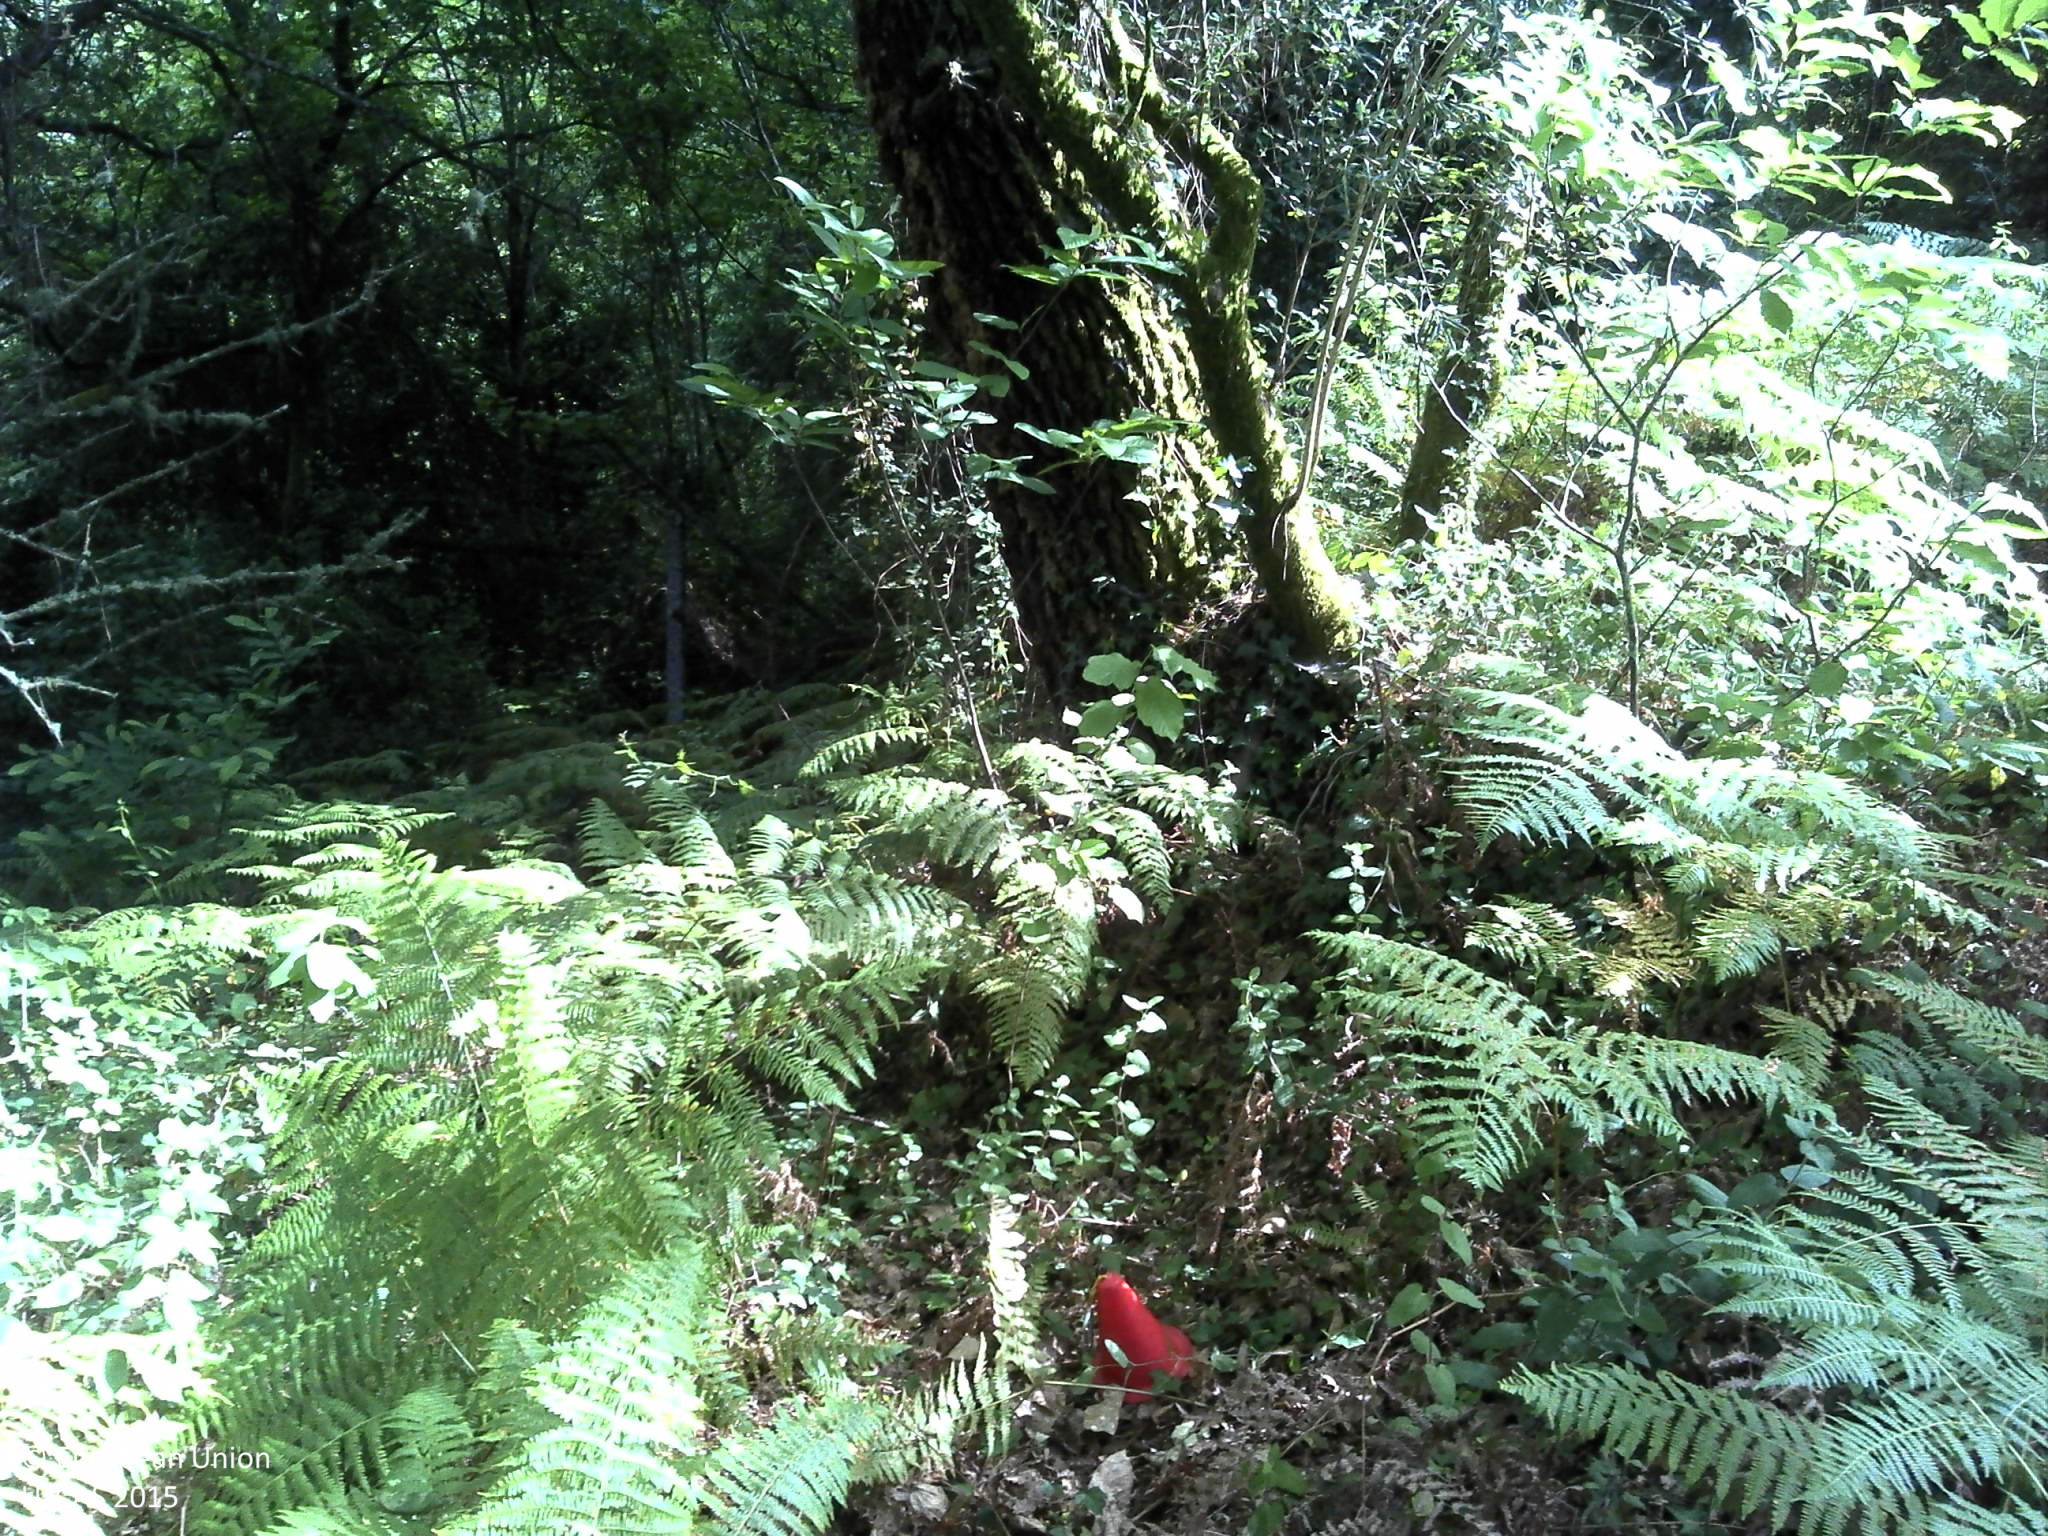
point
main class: Woodland
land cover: Pine dominated mixed woodland
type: coniferous forest of the mediterranean region
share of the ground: > 75 %
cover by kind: broadleaved forest trees 75 %, coniferous forest trees 25 %
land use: Forestry
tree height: > 5 m
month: June
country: PT
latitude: 41.7939
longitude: -8.4379
